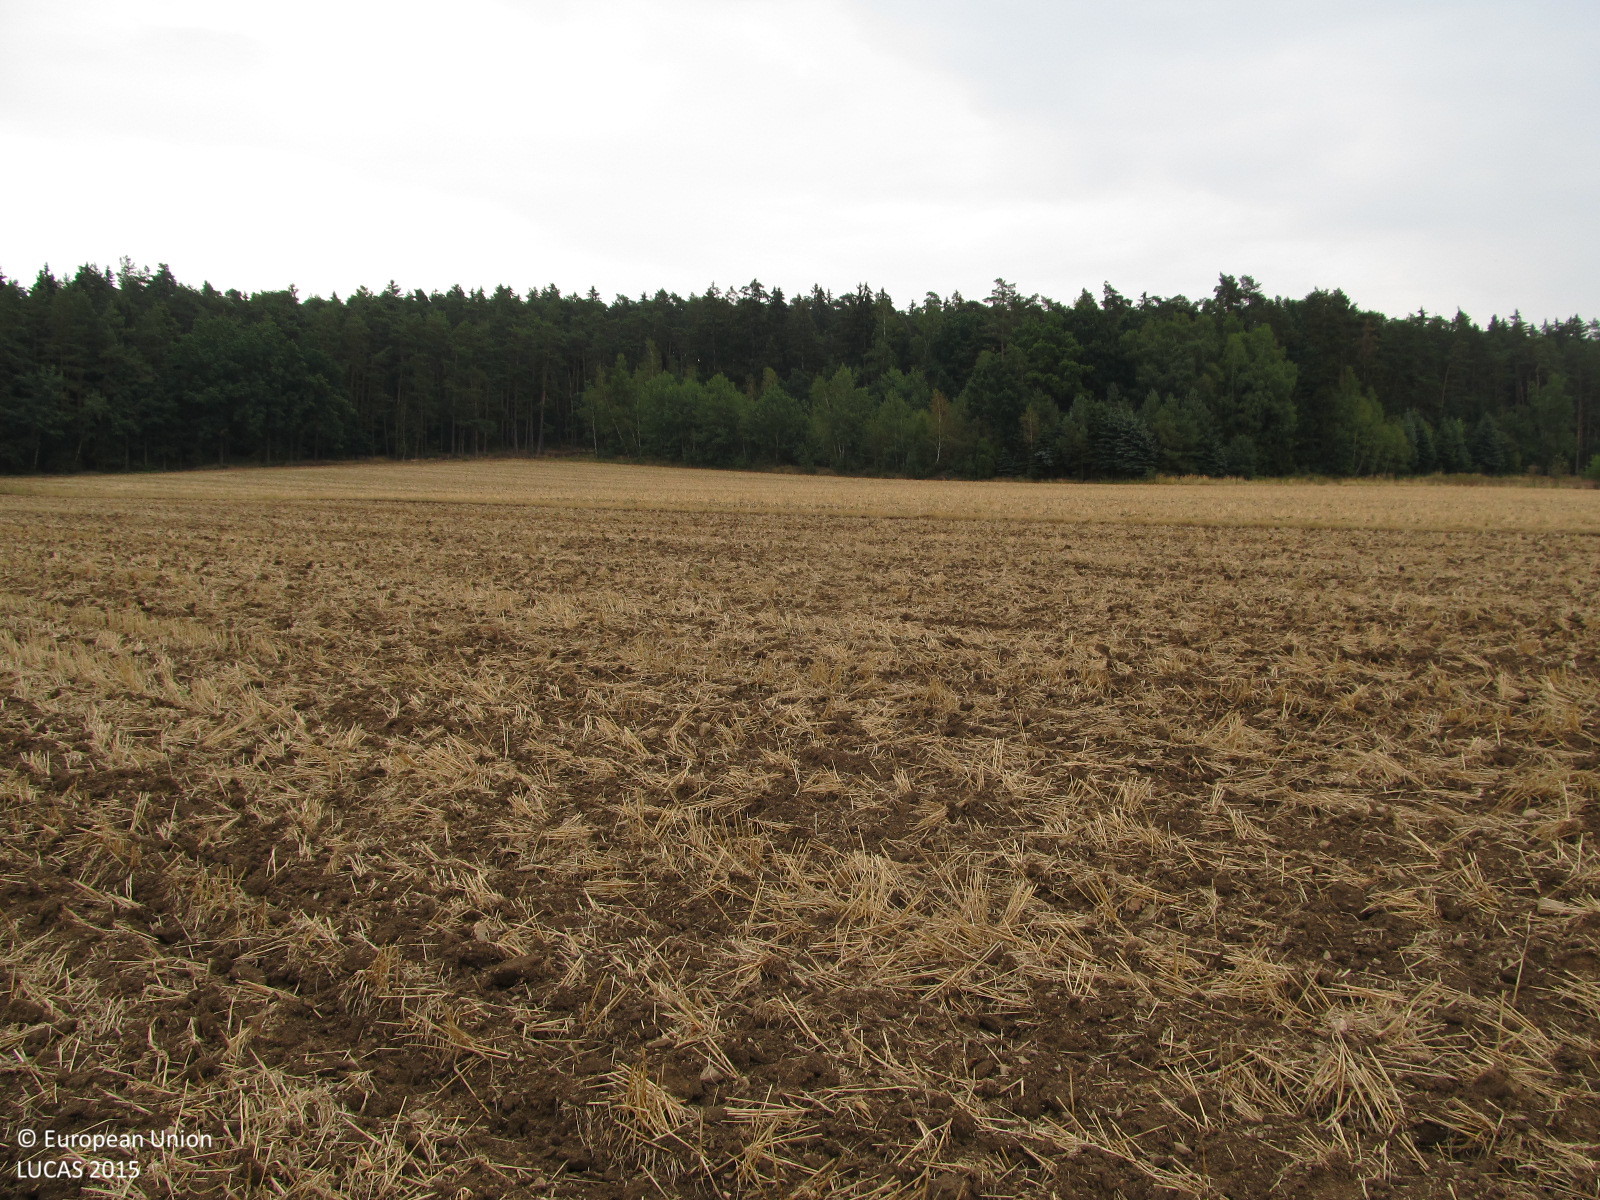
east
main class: Cropland
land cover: Barley
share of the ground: < 10 %
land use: Agriculture (excluding fallow land and kitchen gardens)
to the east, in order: Barley; Other mixed woodland; Tracks; Pine dominated mixed woodland
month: August
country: AT
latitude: 48.8605
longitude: 15.5237
